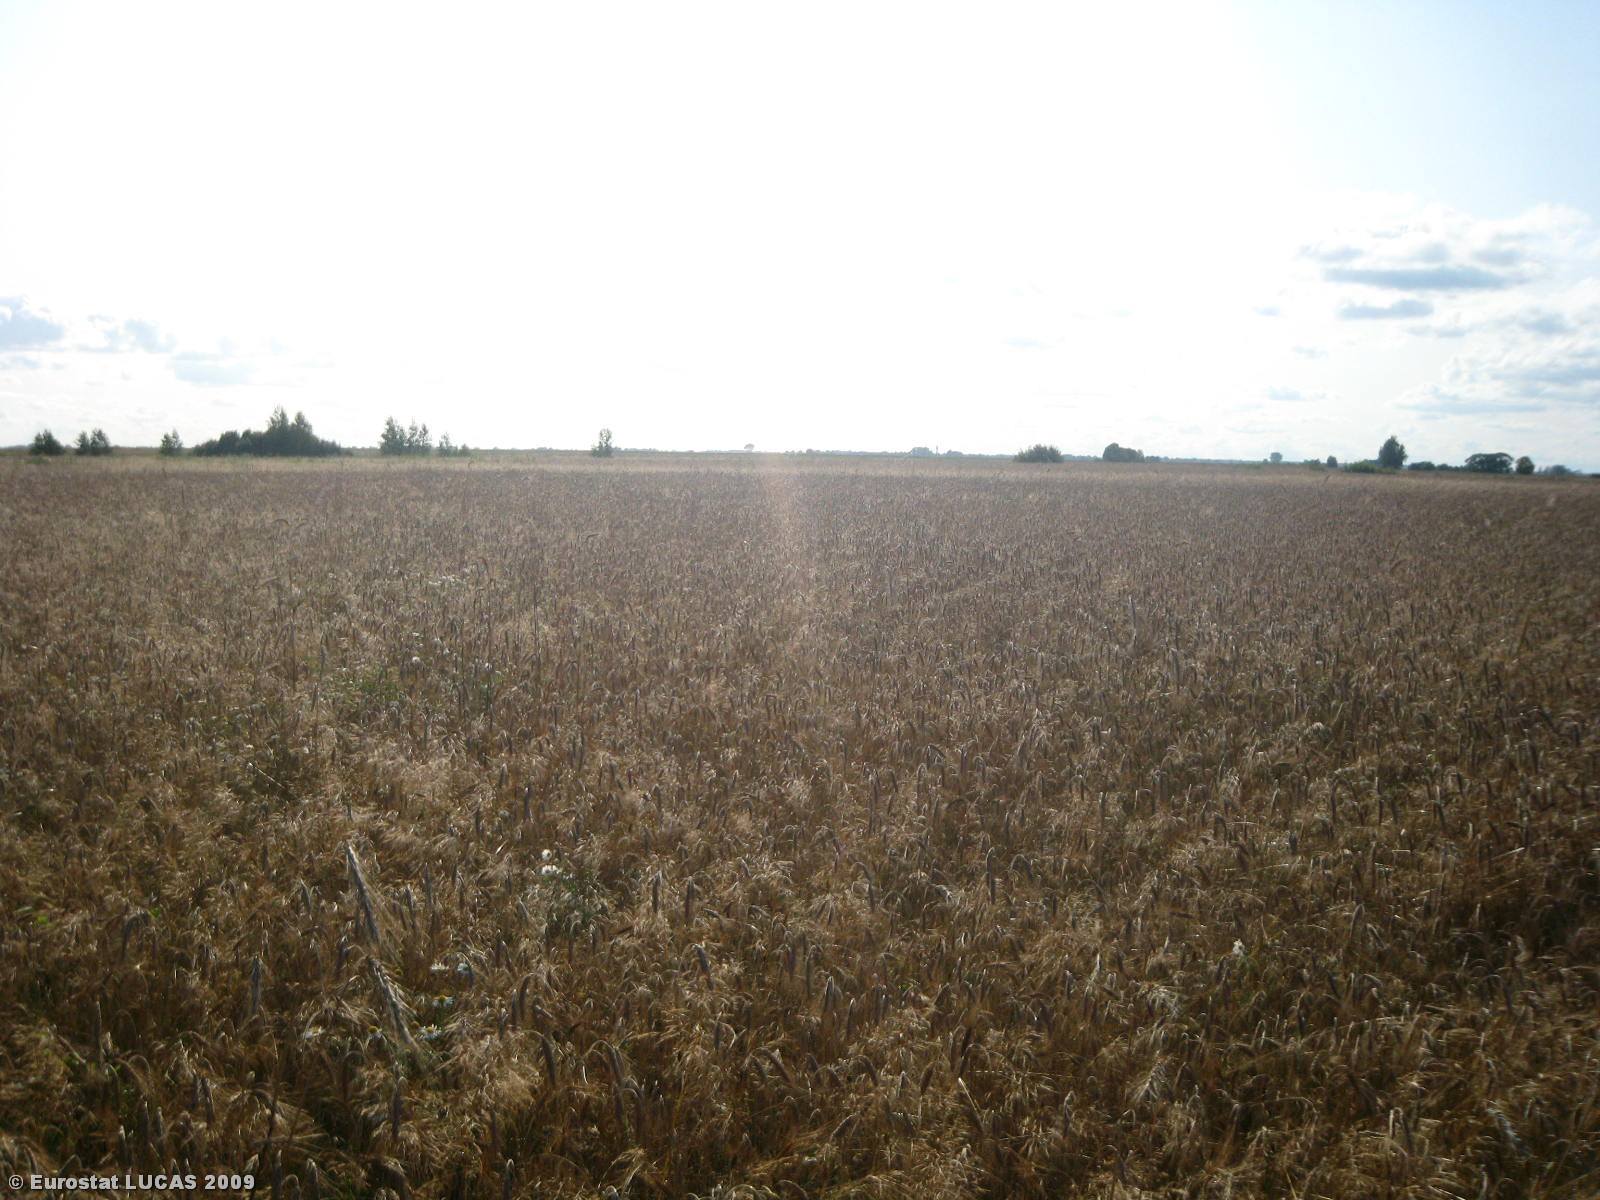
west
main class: Cropland
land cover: Rye
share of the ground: > 75 %
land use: Agriculture (excluding fallow land and kitchen gardens)
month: July
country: LT
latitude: 55.1495
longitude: 23.5923
